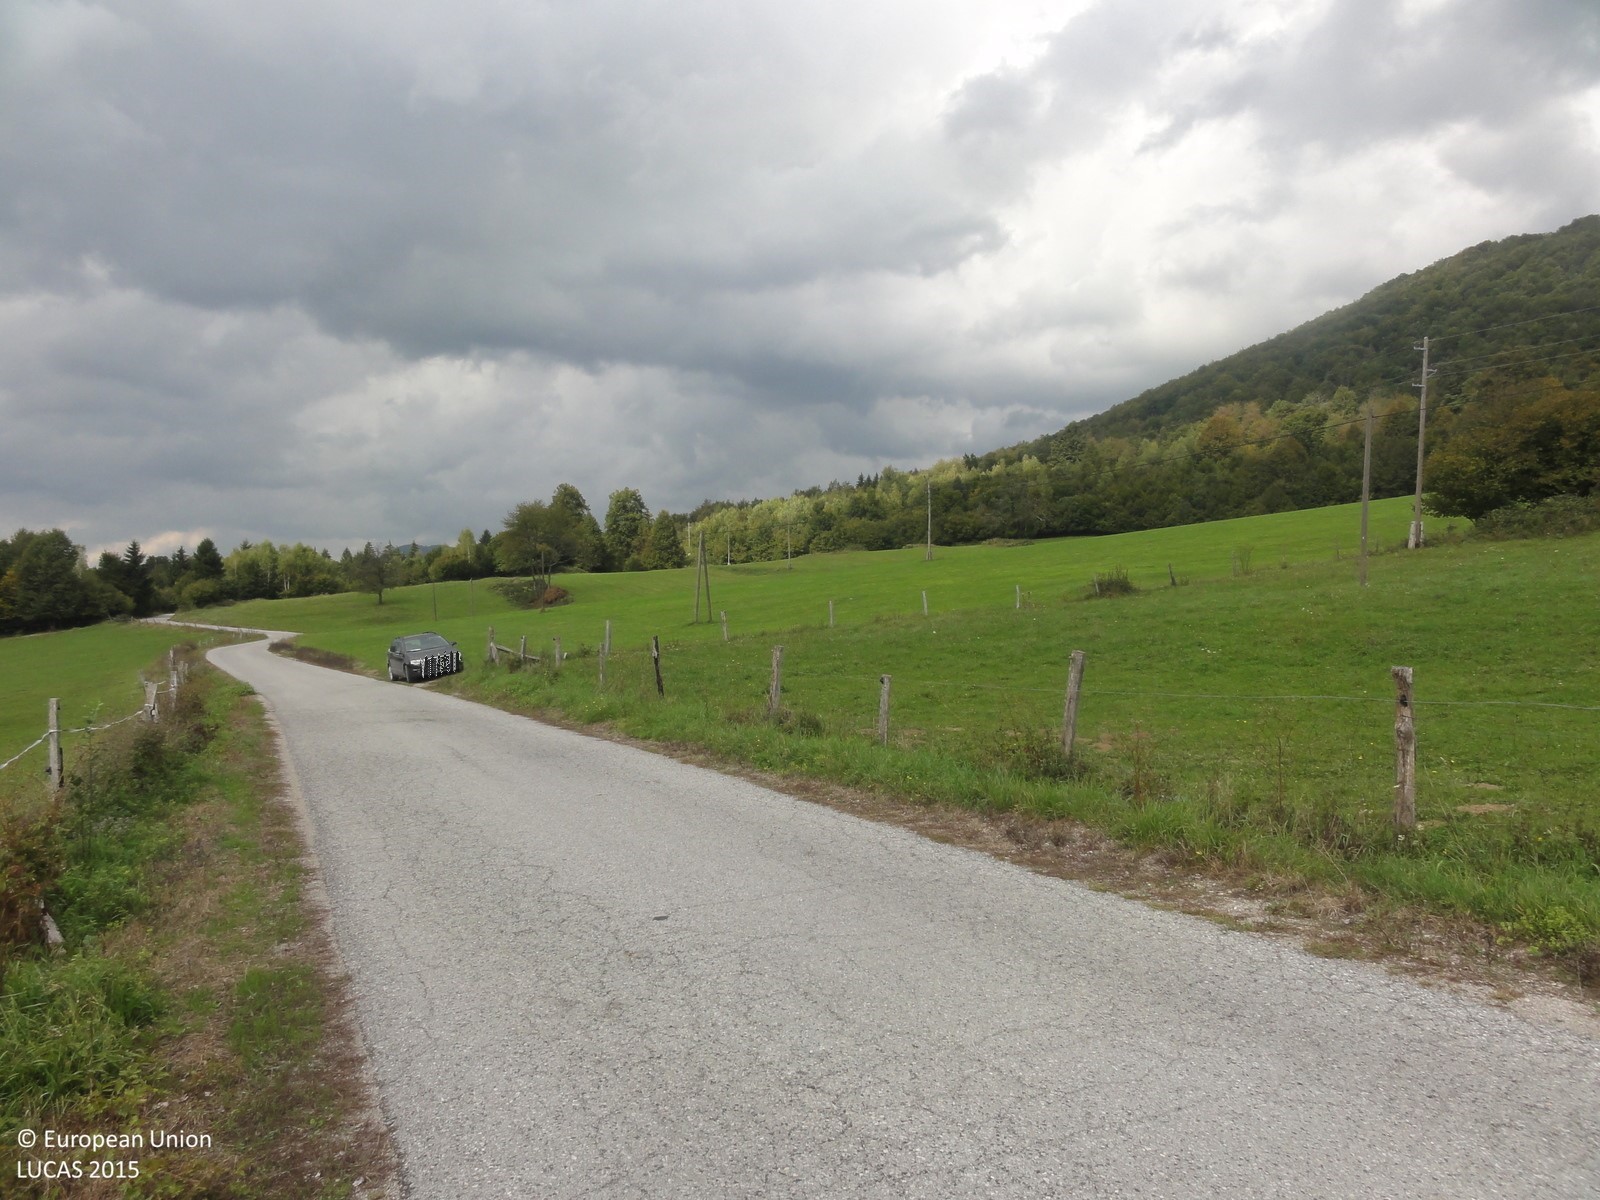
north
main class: Grassland
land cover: Grassland without tree/shrub cover
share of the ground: > 75 %
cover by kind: herbaceous plants 100 %
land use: Agriculture (excluding fallow land and kitchen gardens)
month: September
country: SI
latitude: 45.5303
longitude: 15.0023
